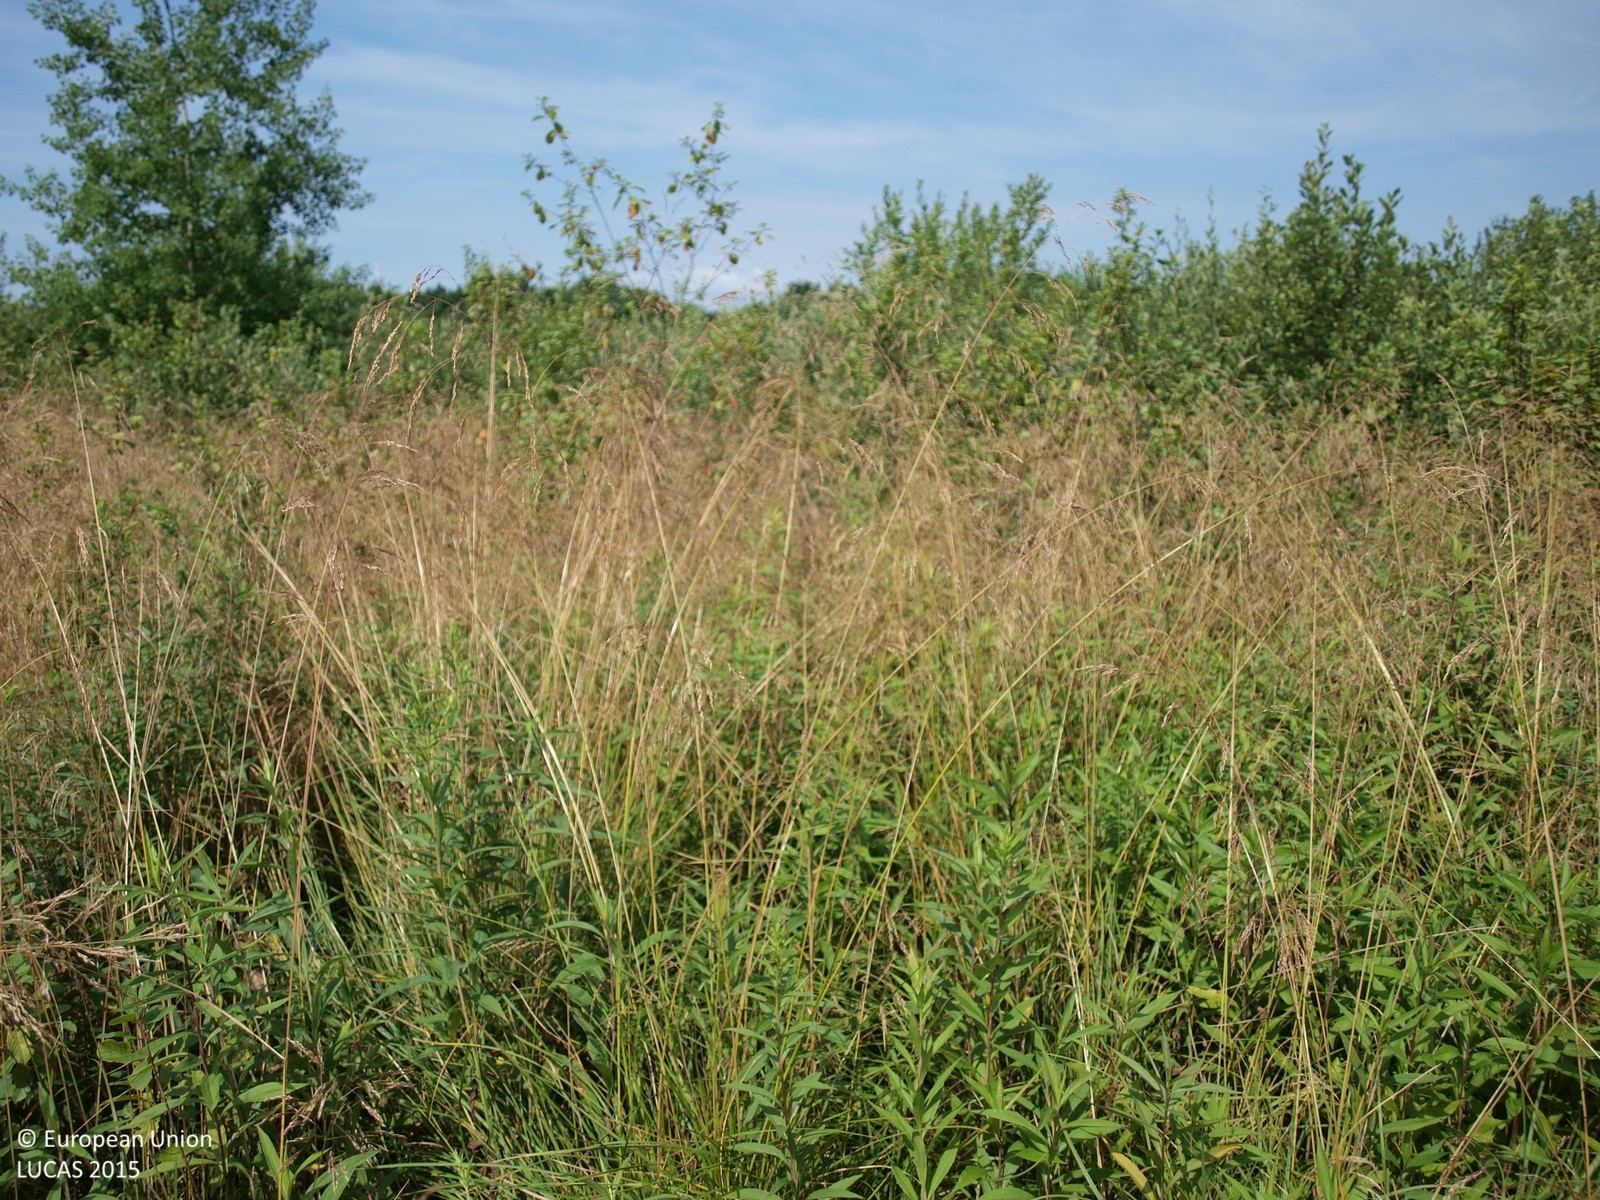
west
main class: Grassland
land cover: Grassland with sparse tree/shrub cover
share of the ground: > 75 %
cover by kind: herbaceous plants 90 %, broadleaved forest trees 5 %, shrubs 5 %
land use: Fallow land
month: July
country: HR
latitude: 45.7399
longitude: 15.8452
